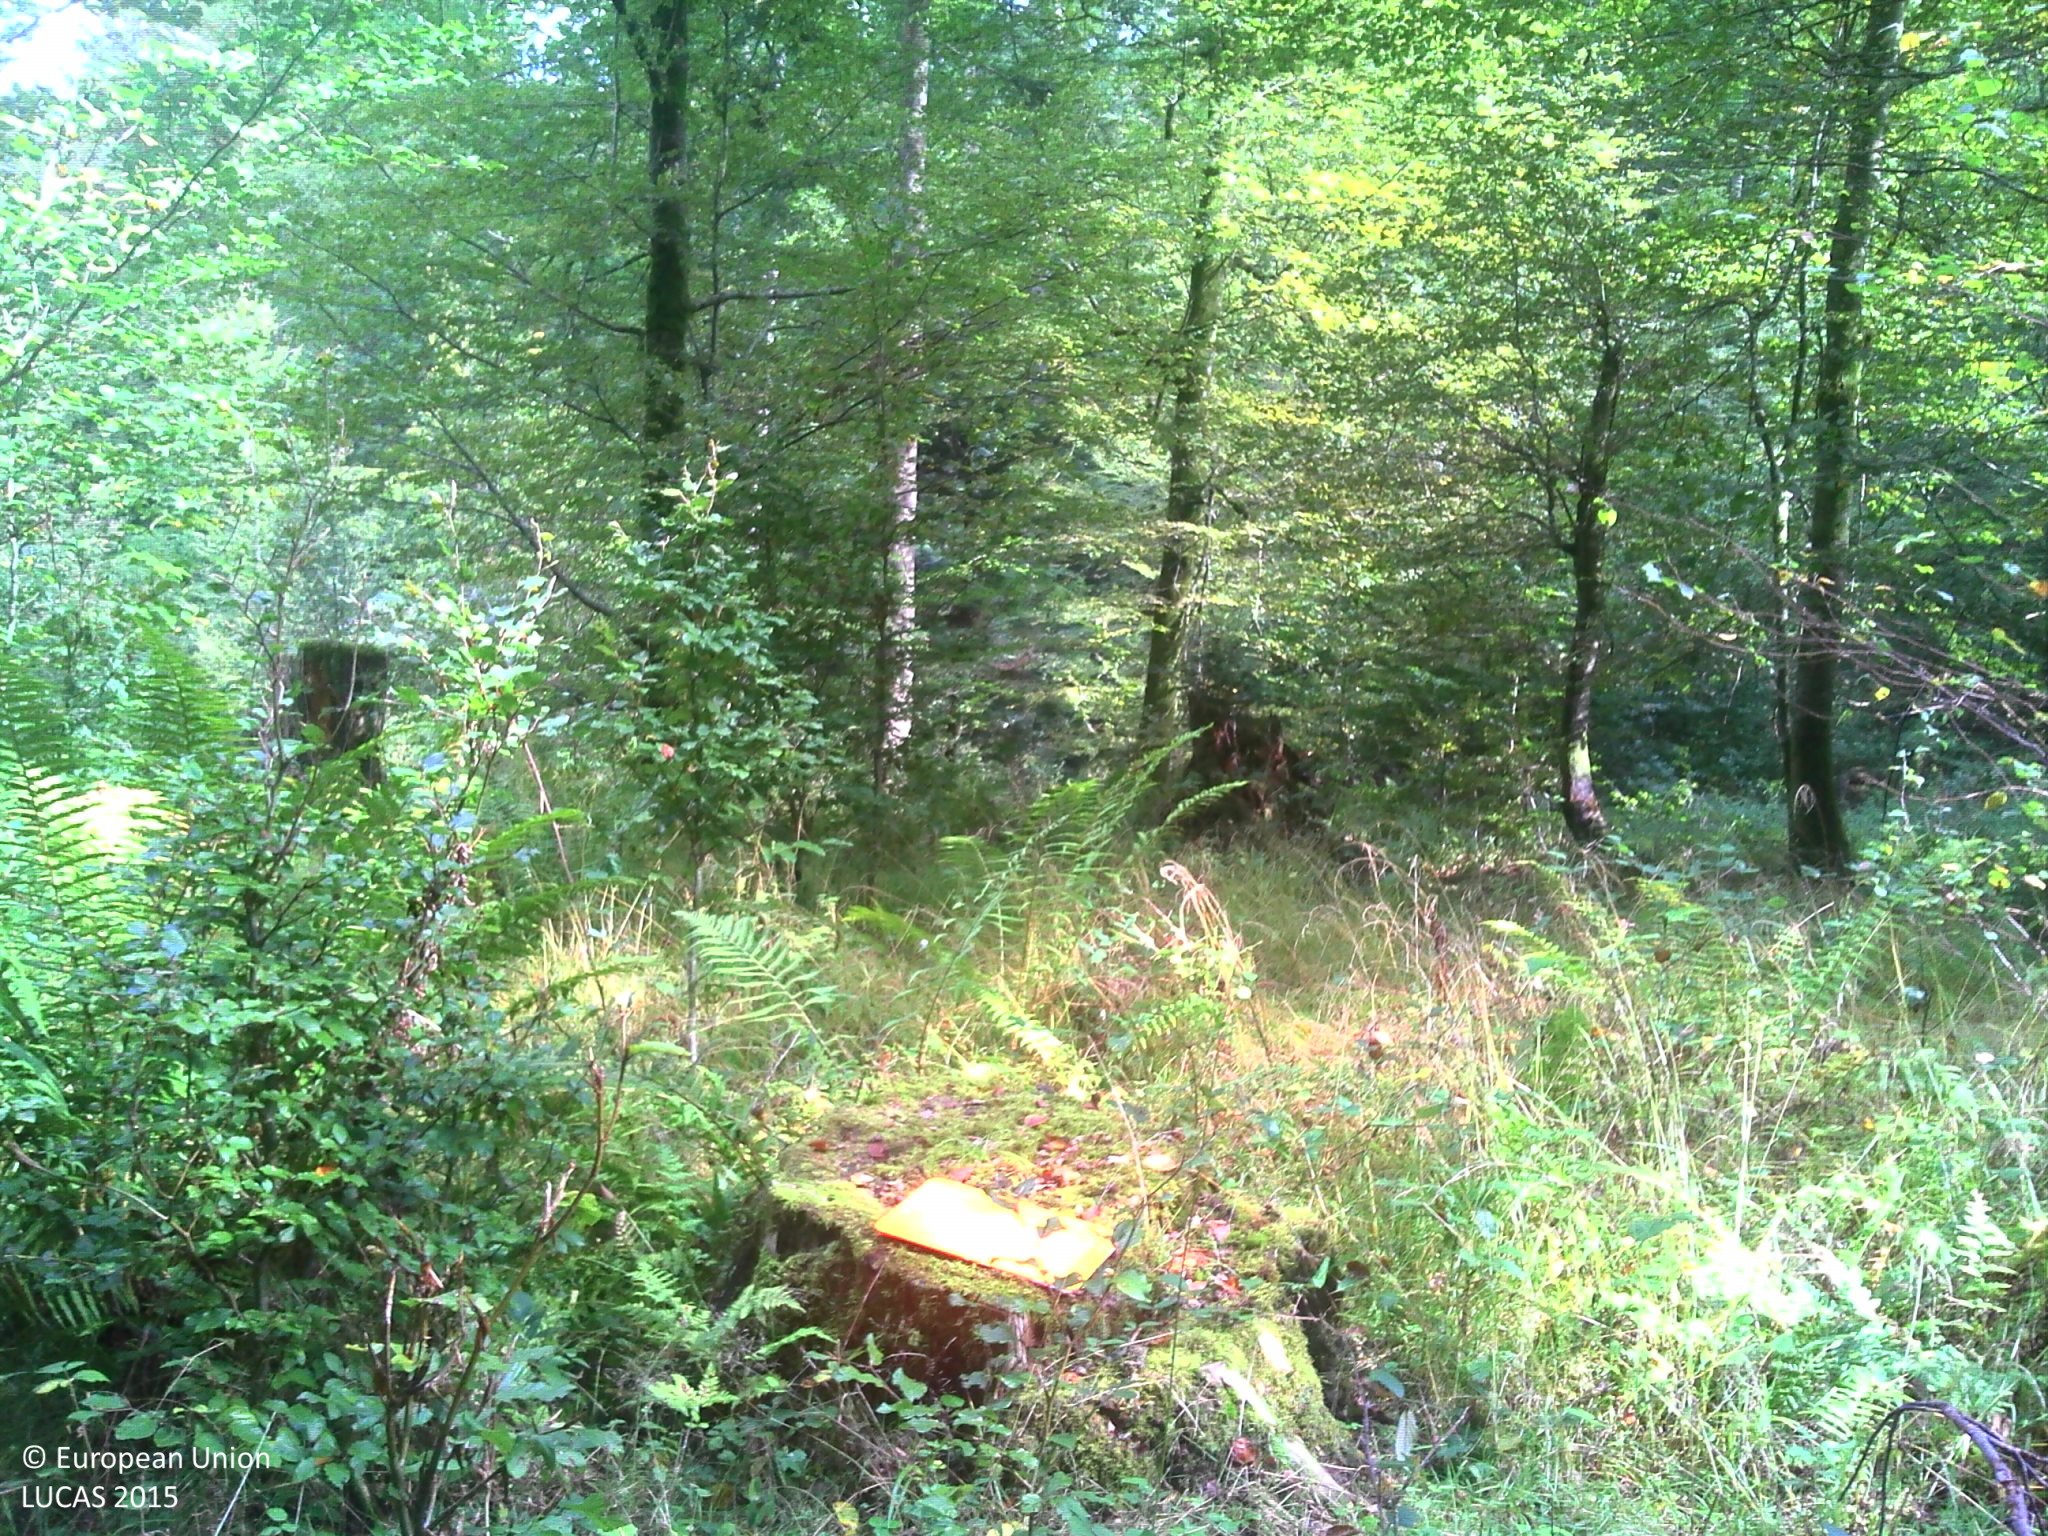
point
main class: Woodland
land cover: Other mixed woodland
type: hemiboreal forest and nemoral coniferous forest and mixed broadleaved-coniferous forest
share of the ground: > 75 %
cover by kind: broadleaved forest trees 55 %, coniferous forest trees 20 %, shrubs 10 %, herbaceous plants 10 %, lichens and mosses 5 %
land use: Forestry
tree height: > 5 m
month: September
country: FR
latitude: 48.4487
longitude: 6.8505
